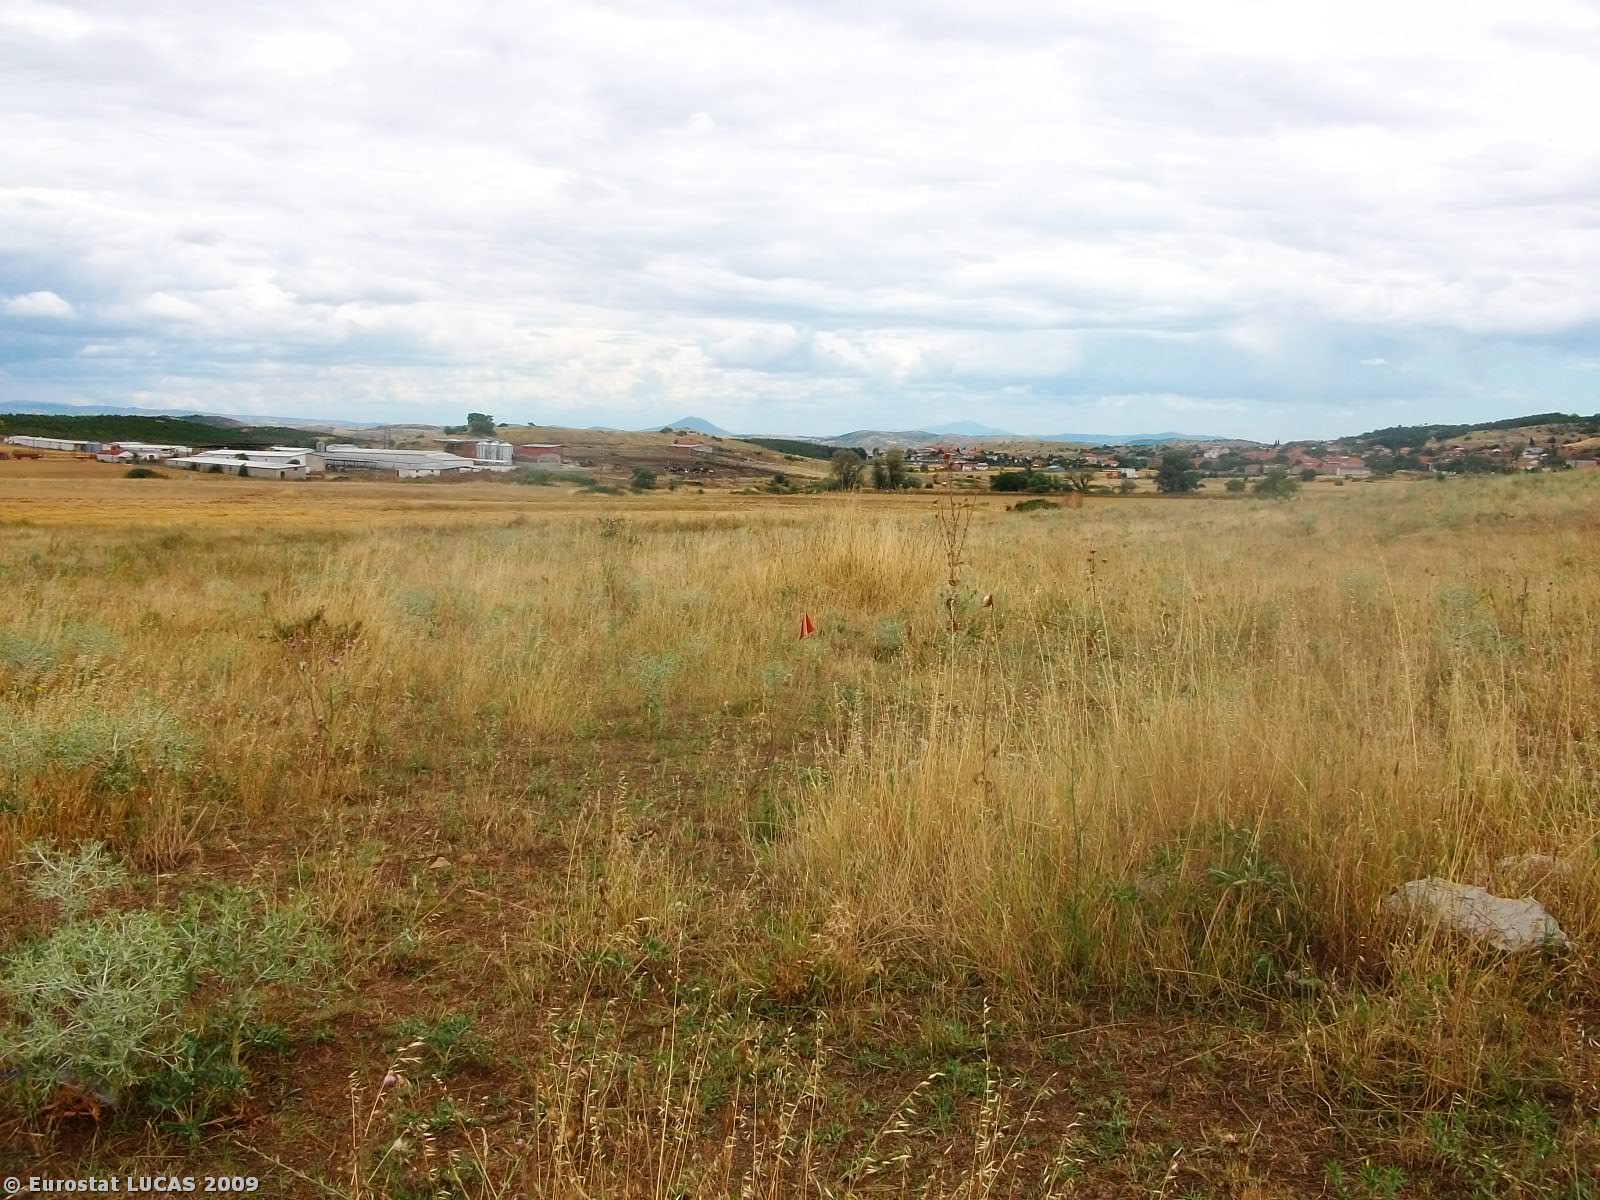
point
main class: Grassland
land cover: Grassland without tree/shrub cover
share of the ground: > 75 %
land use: Unused
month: June
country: GR
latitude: 41.0083
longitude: 22.7192
